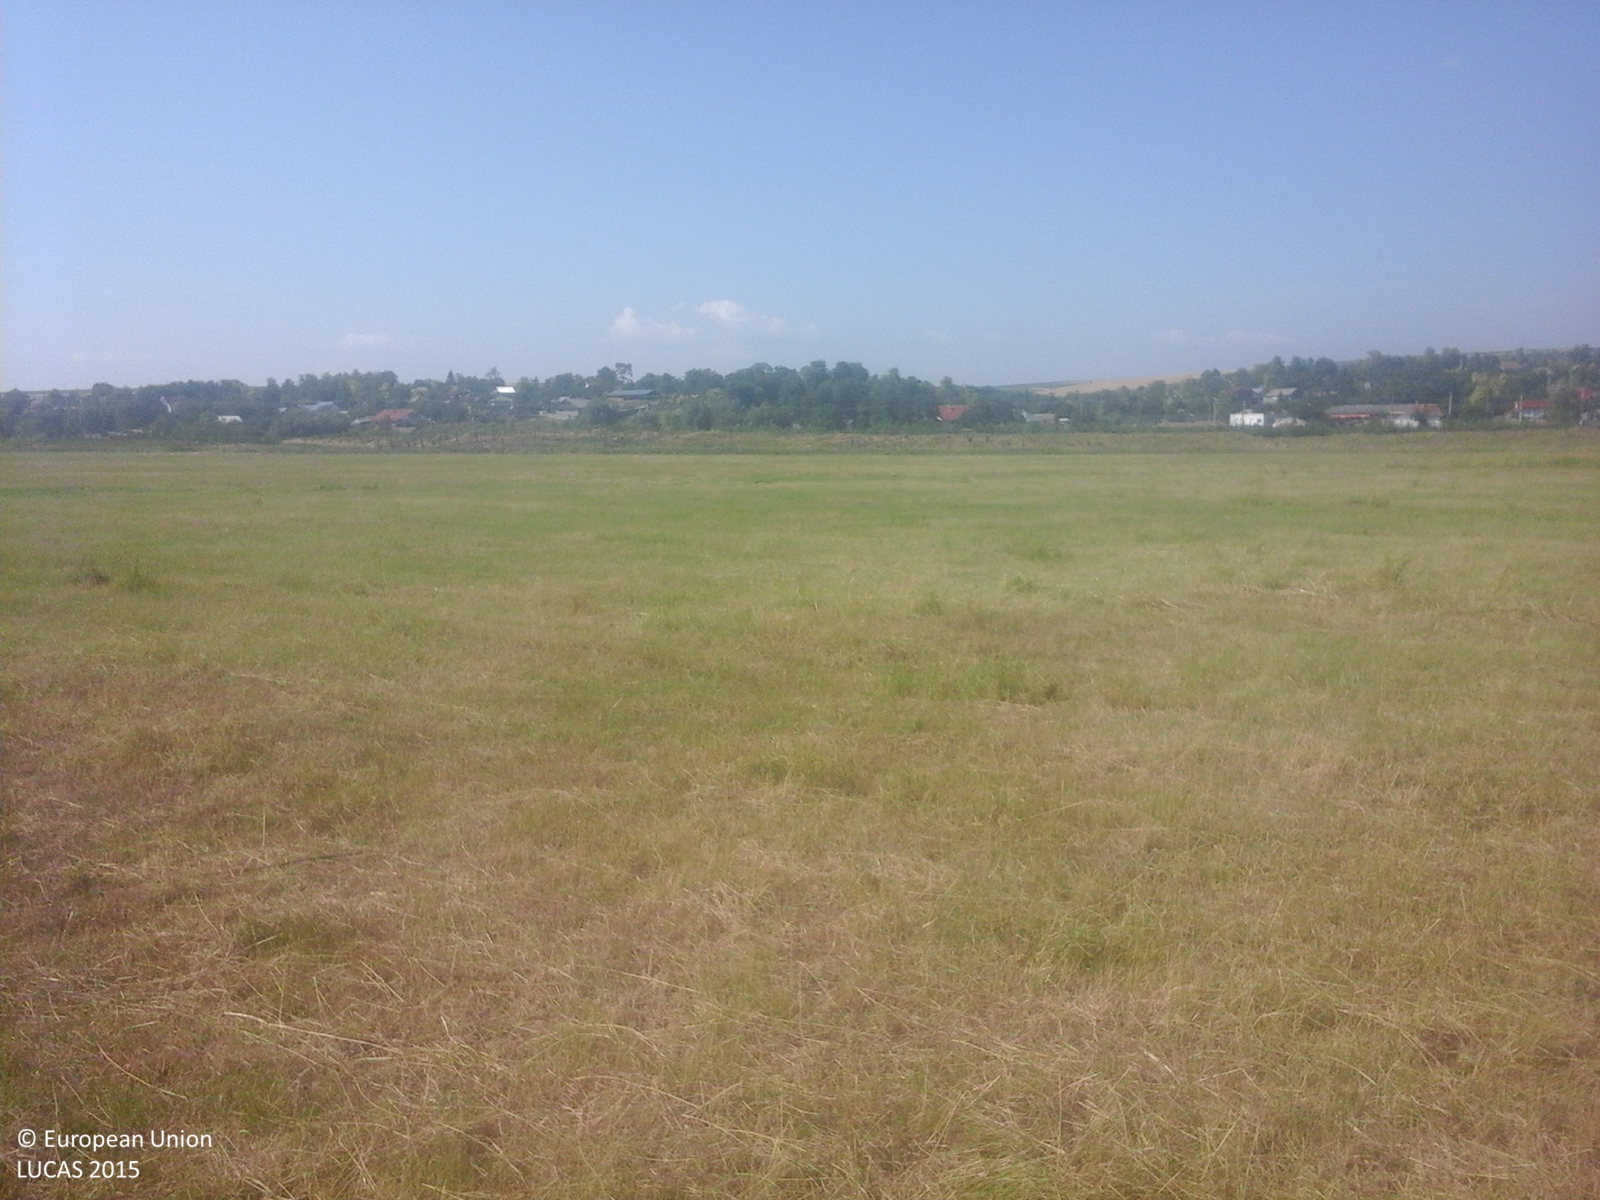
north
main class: Grassland
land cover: Grassland without tree/shrub cover
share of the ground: > 75 %
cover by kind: herbaceous plants 100 %
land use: Agriculture (excluding fallow land and kitchen gardens)
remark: Harvested field
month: June
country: RO
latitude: 46.8042
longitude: 27.5284
